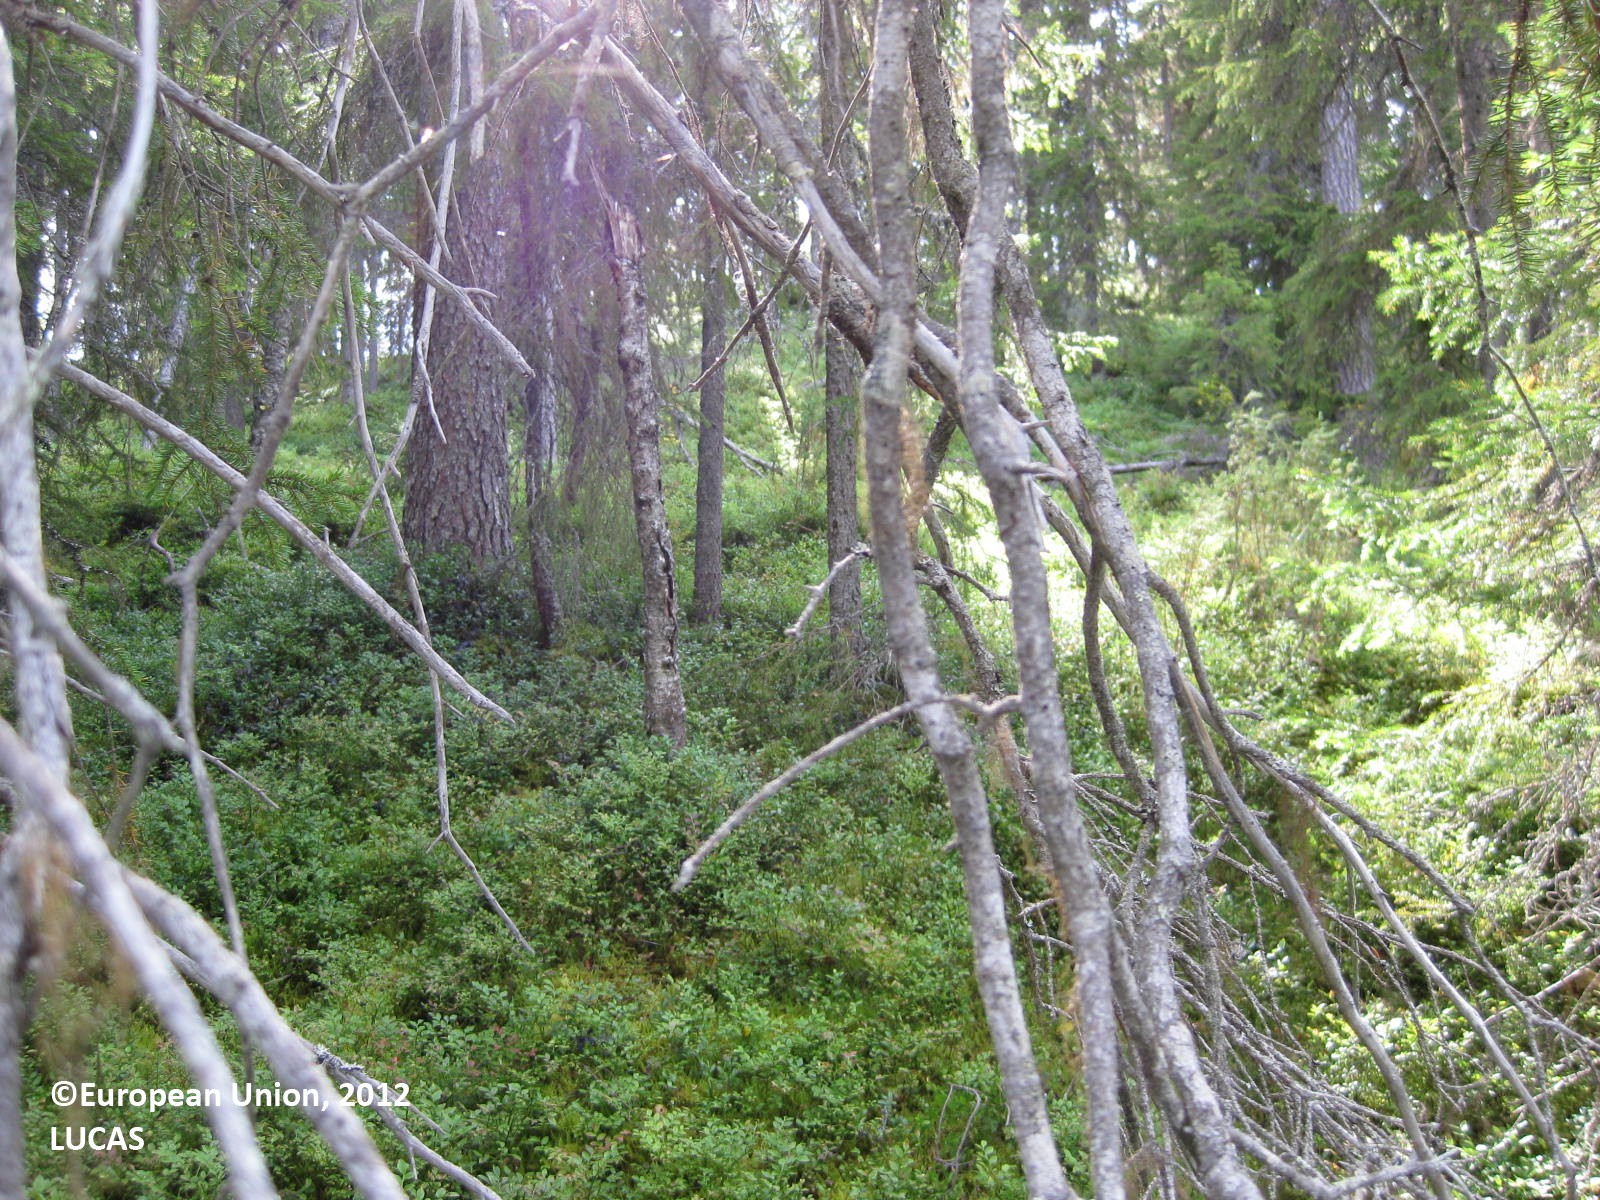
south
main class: Woodland
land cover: Spruce dominated coniferous woodland
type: boreal forest
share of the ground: 50 - 75 %
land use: Forestry
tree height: > 5 m
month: August
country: FI
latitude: 66.1230
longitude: 29.7476
